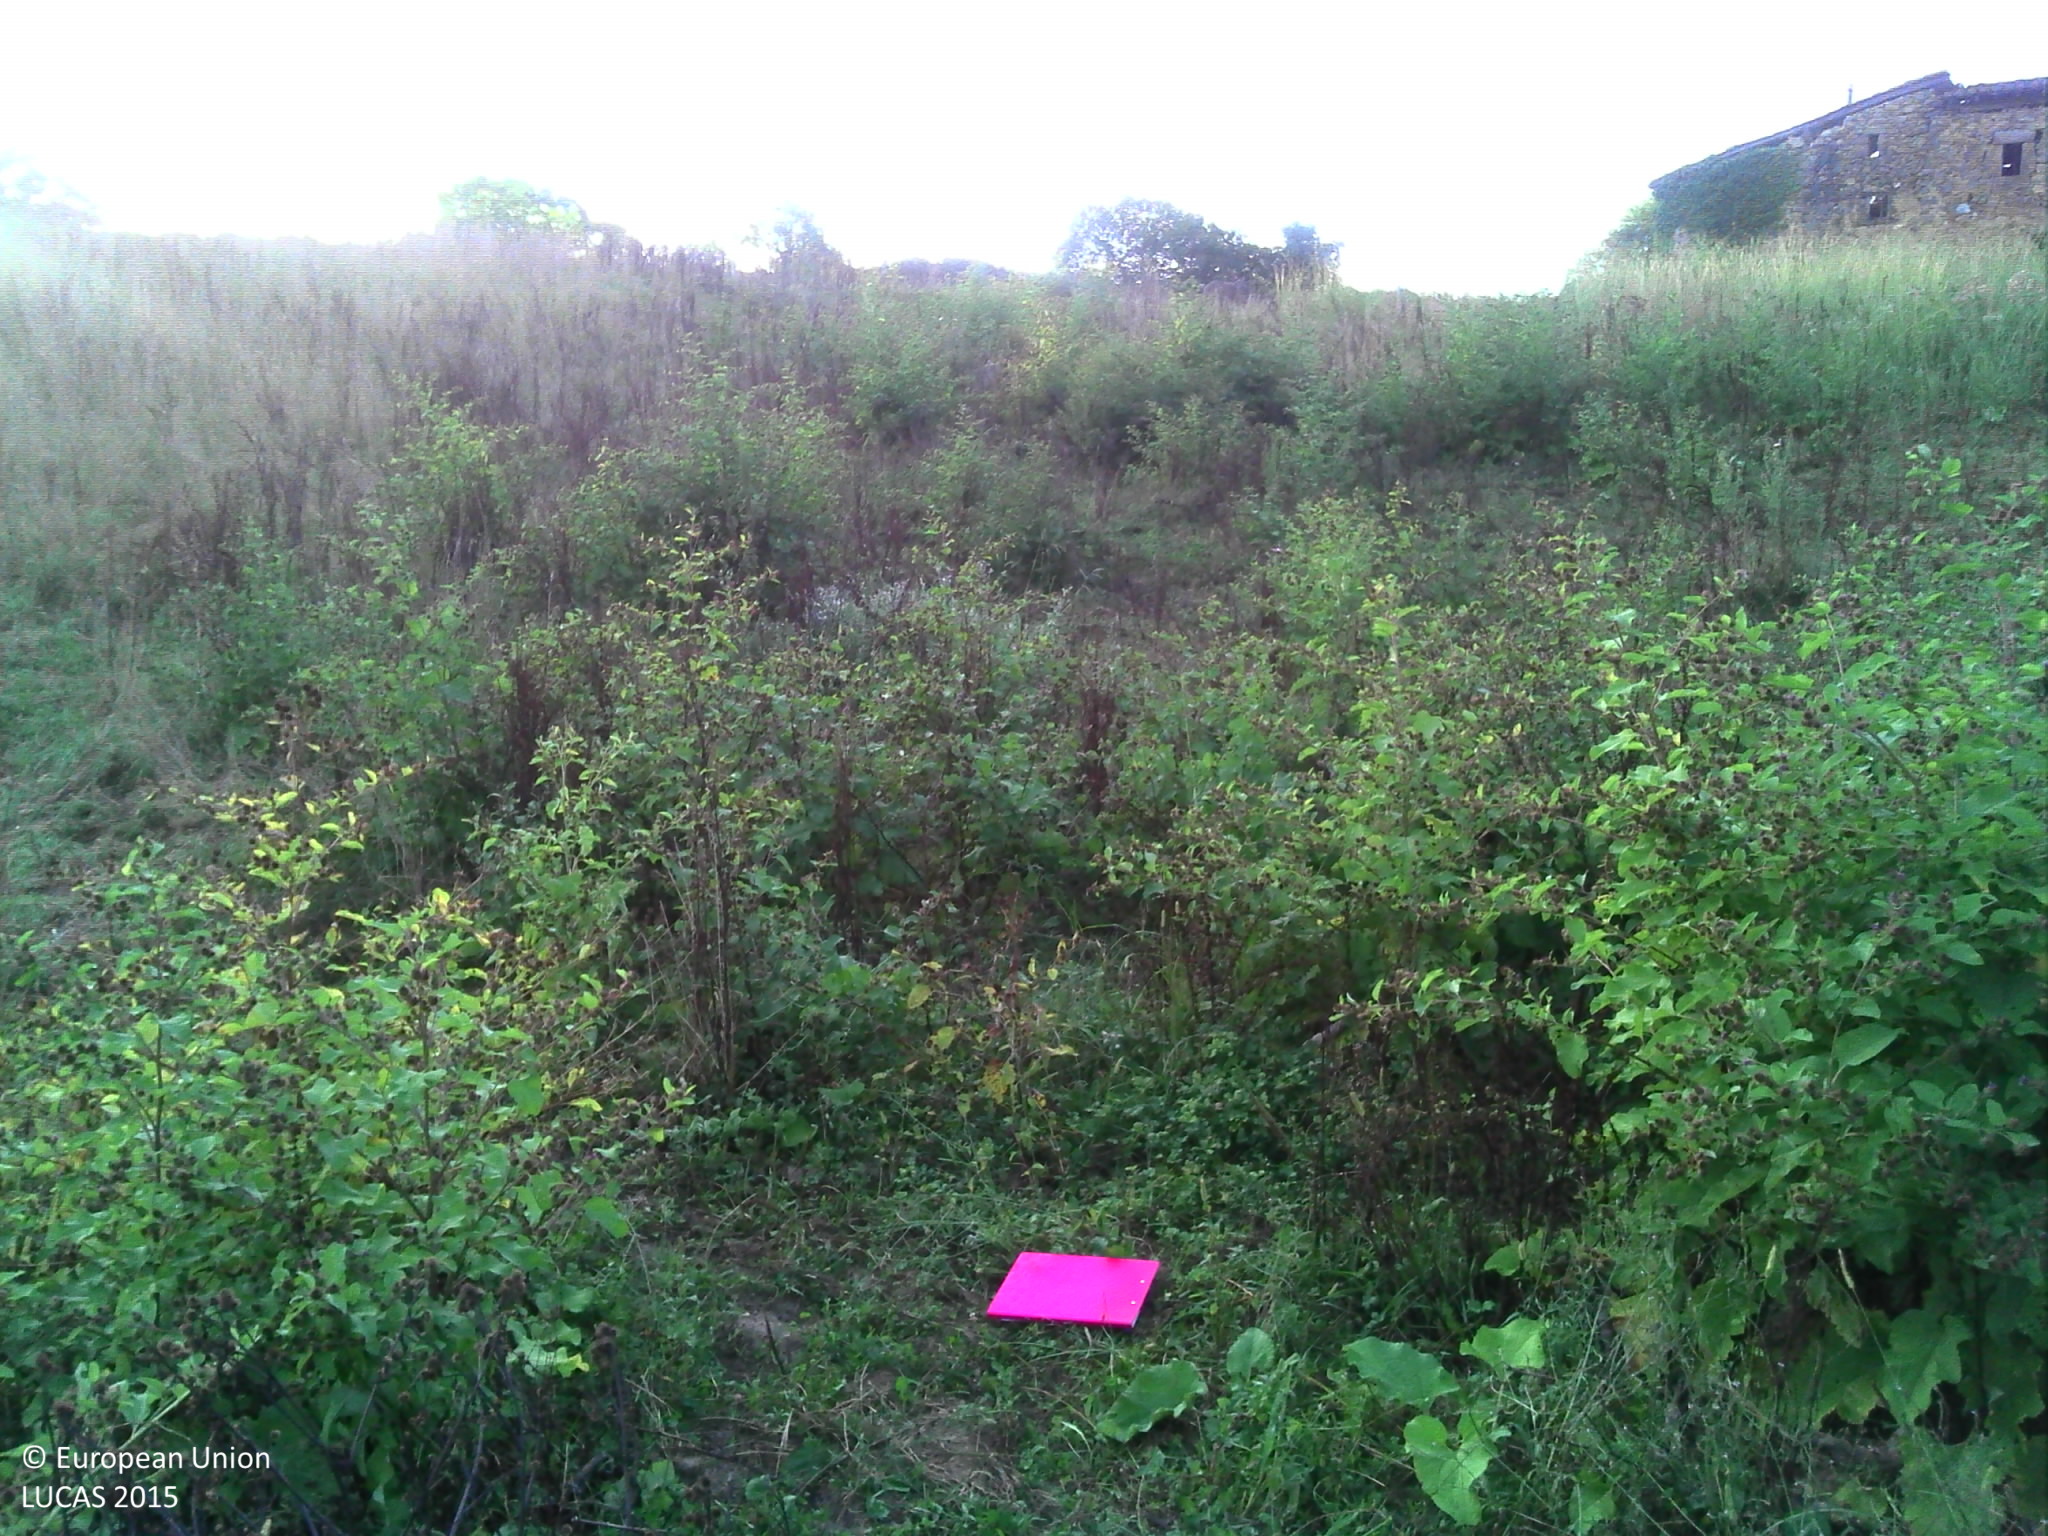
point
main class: Grassland
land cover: Spontaneously vegetated surfaces
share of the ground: > 75 %
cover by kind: herbaceous plants 95 %, shrubs 5 %
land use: Agriculture (excluding fallow land and kitchen gardens)
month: August
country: FR
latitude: 43.2908
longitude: -1.1678
